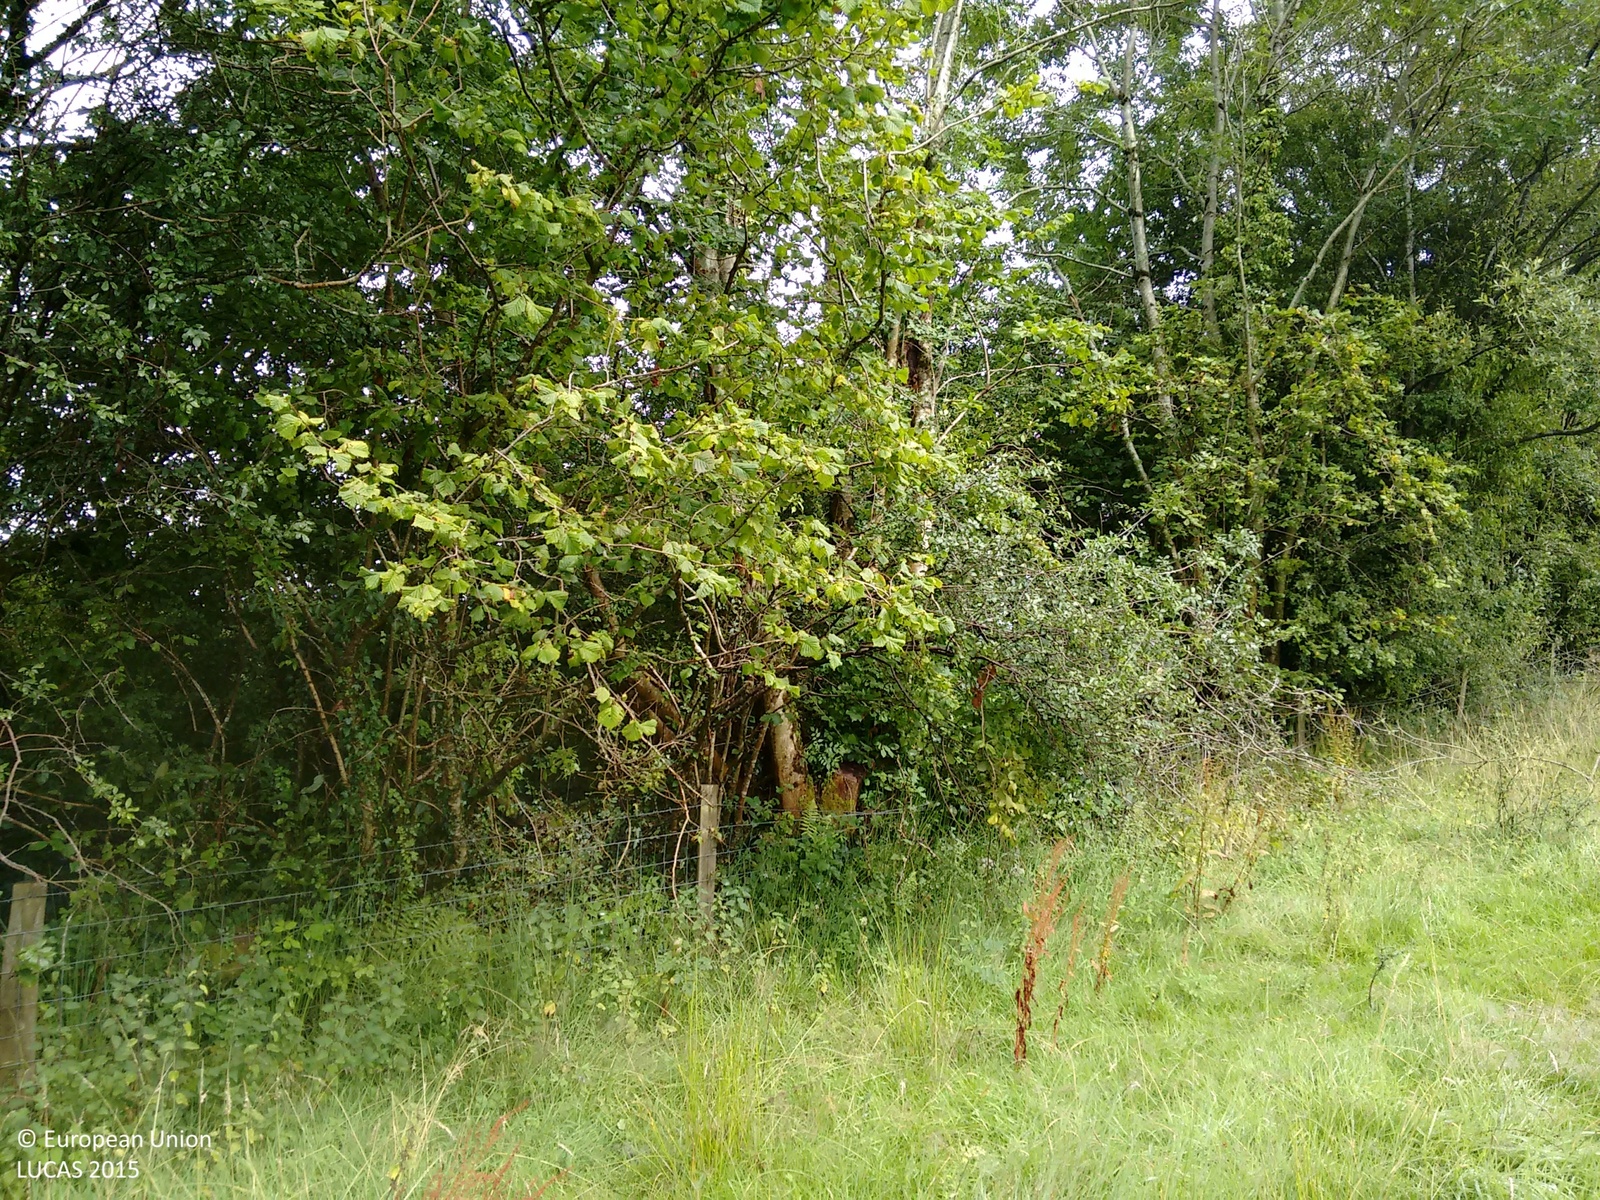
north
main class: Grassland
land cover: Grassland without tree/shrub cover
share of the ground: > 75 %
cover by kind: herbaceous plants 100 %
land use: Agriculture (excluding fallow land and kitchen gardens)
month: August
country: GB
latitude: 51.9175
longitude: -4.0681
